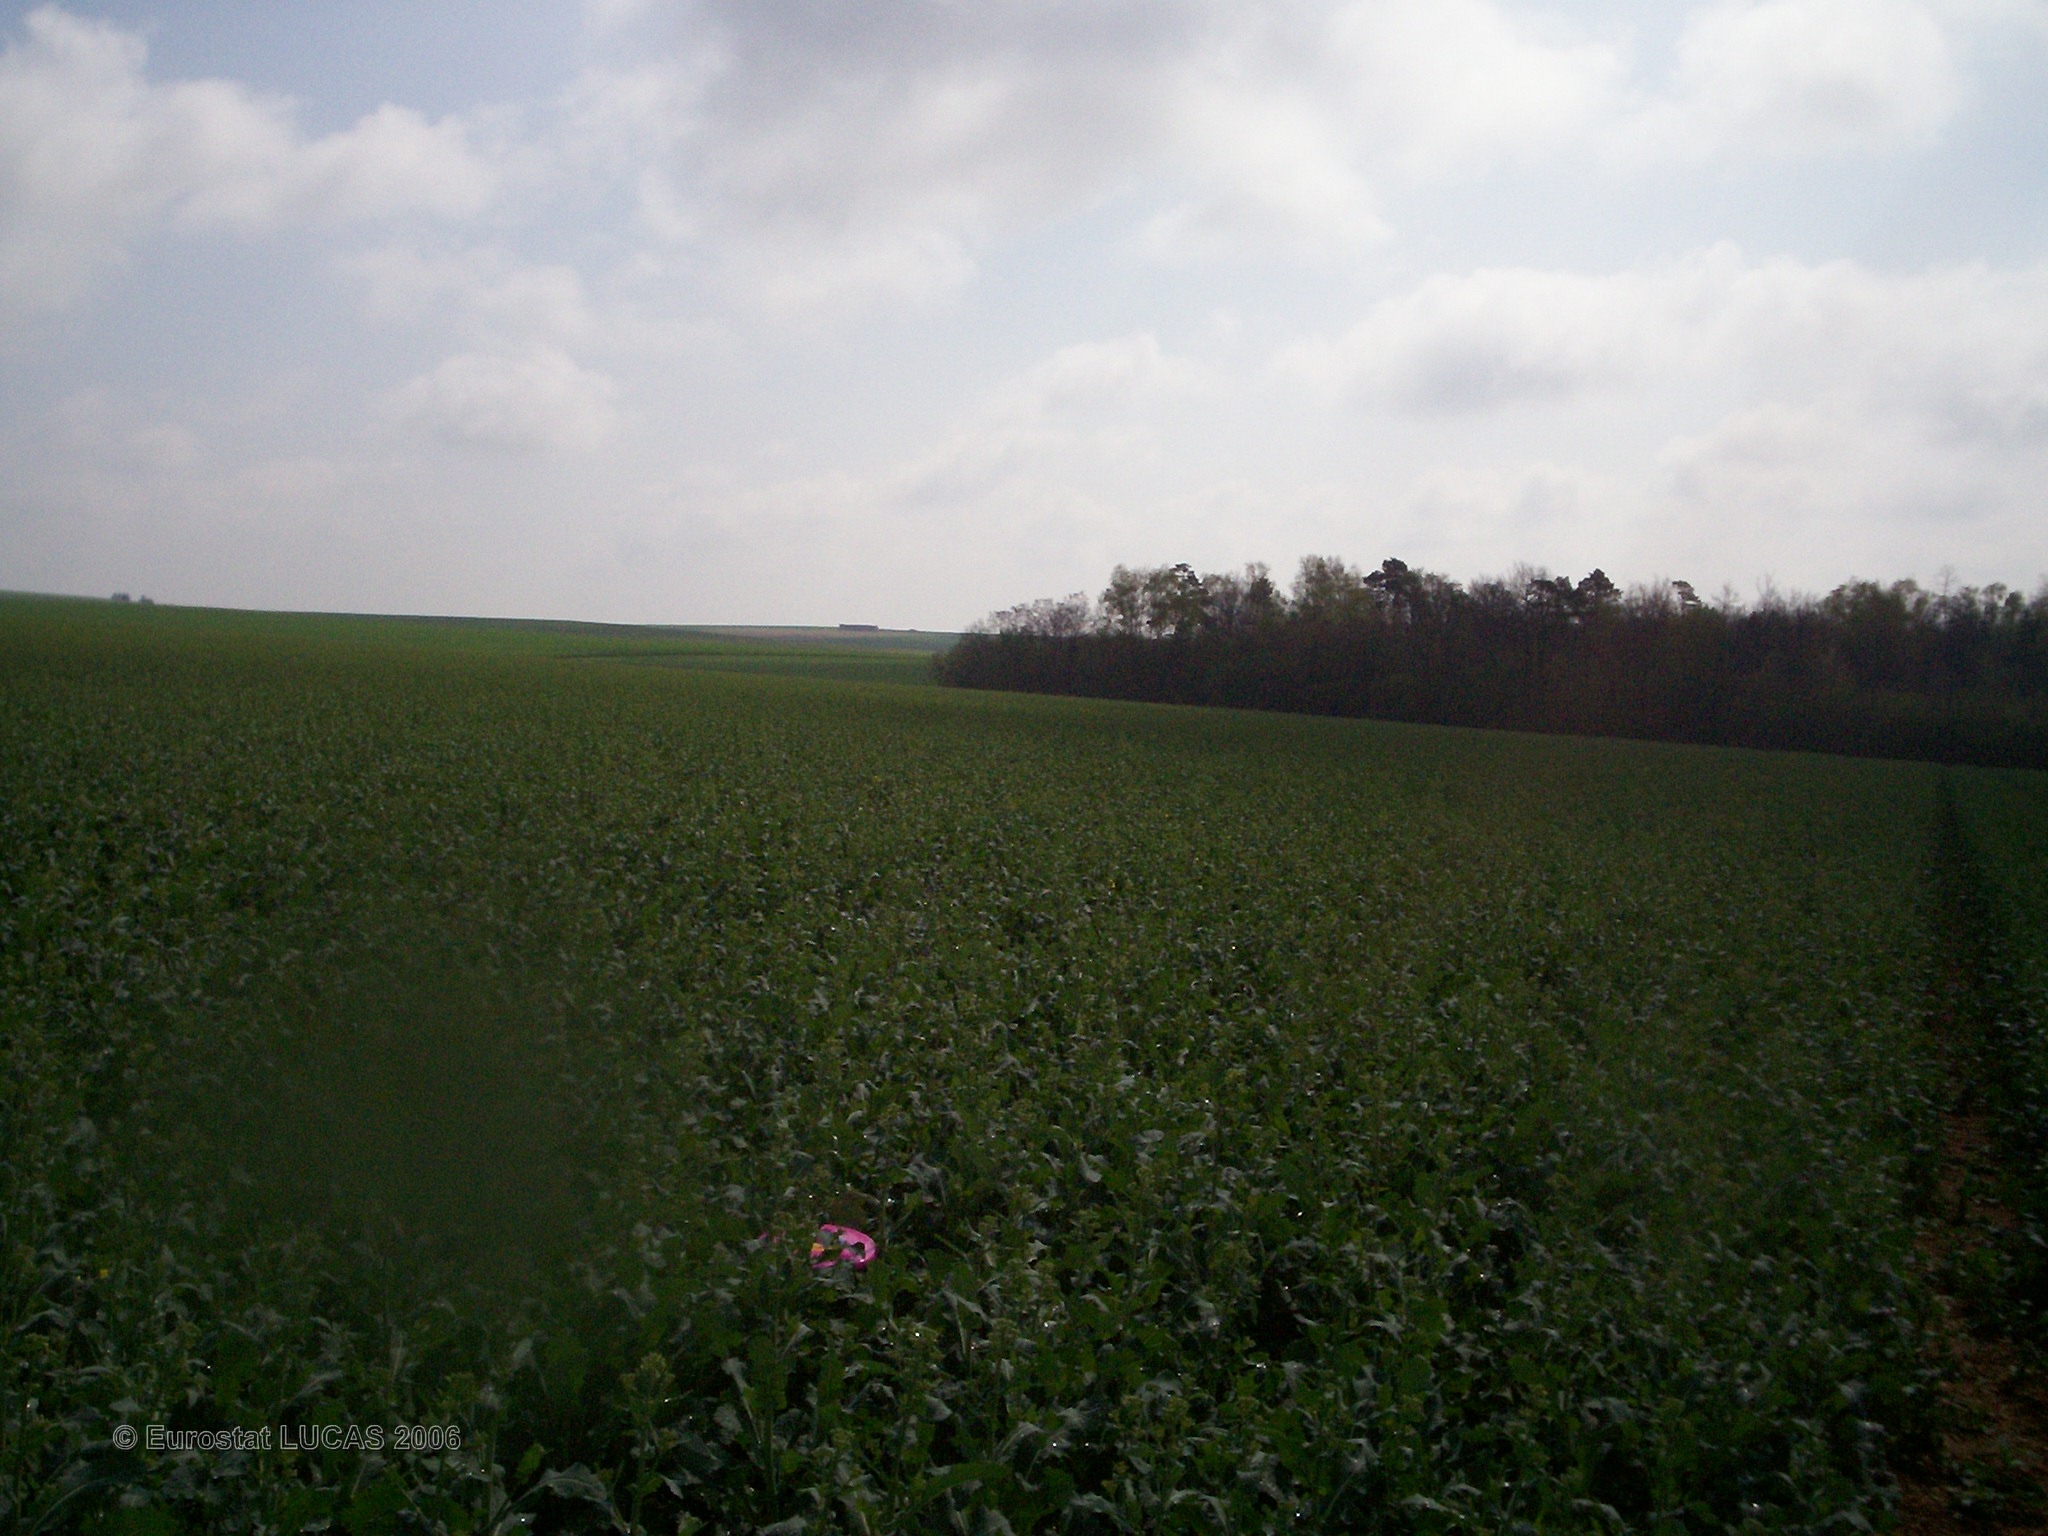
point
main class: Cropland
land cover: Rape and turnip rape
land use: Agriculture (excluding fallow land and kitchen gardens)
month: April
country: FR
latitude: 47.7449
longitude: 3.8483
